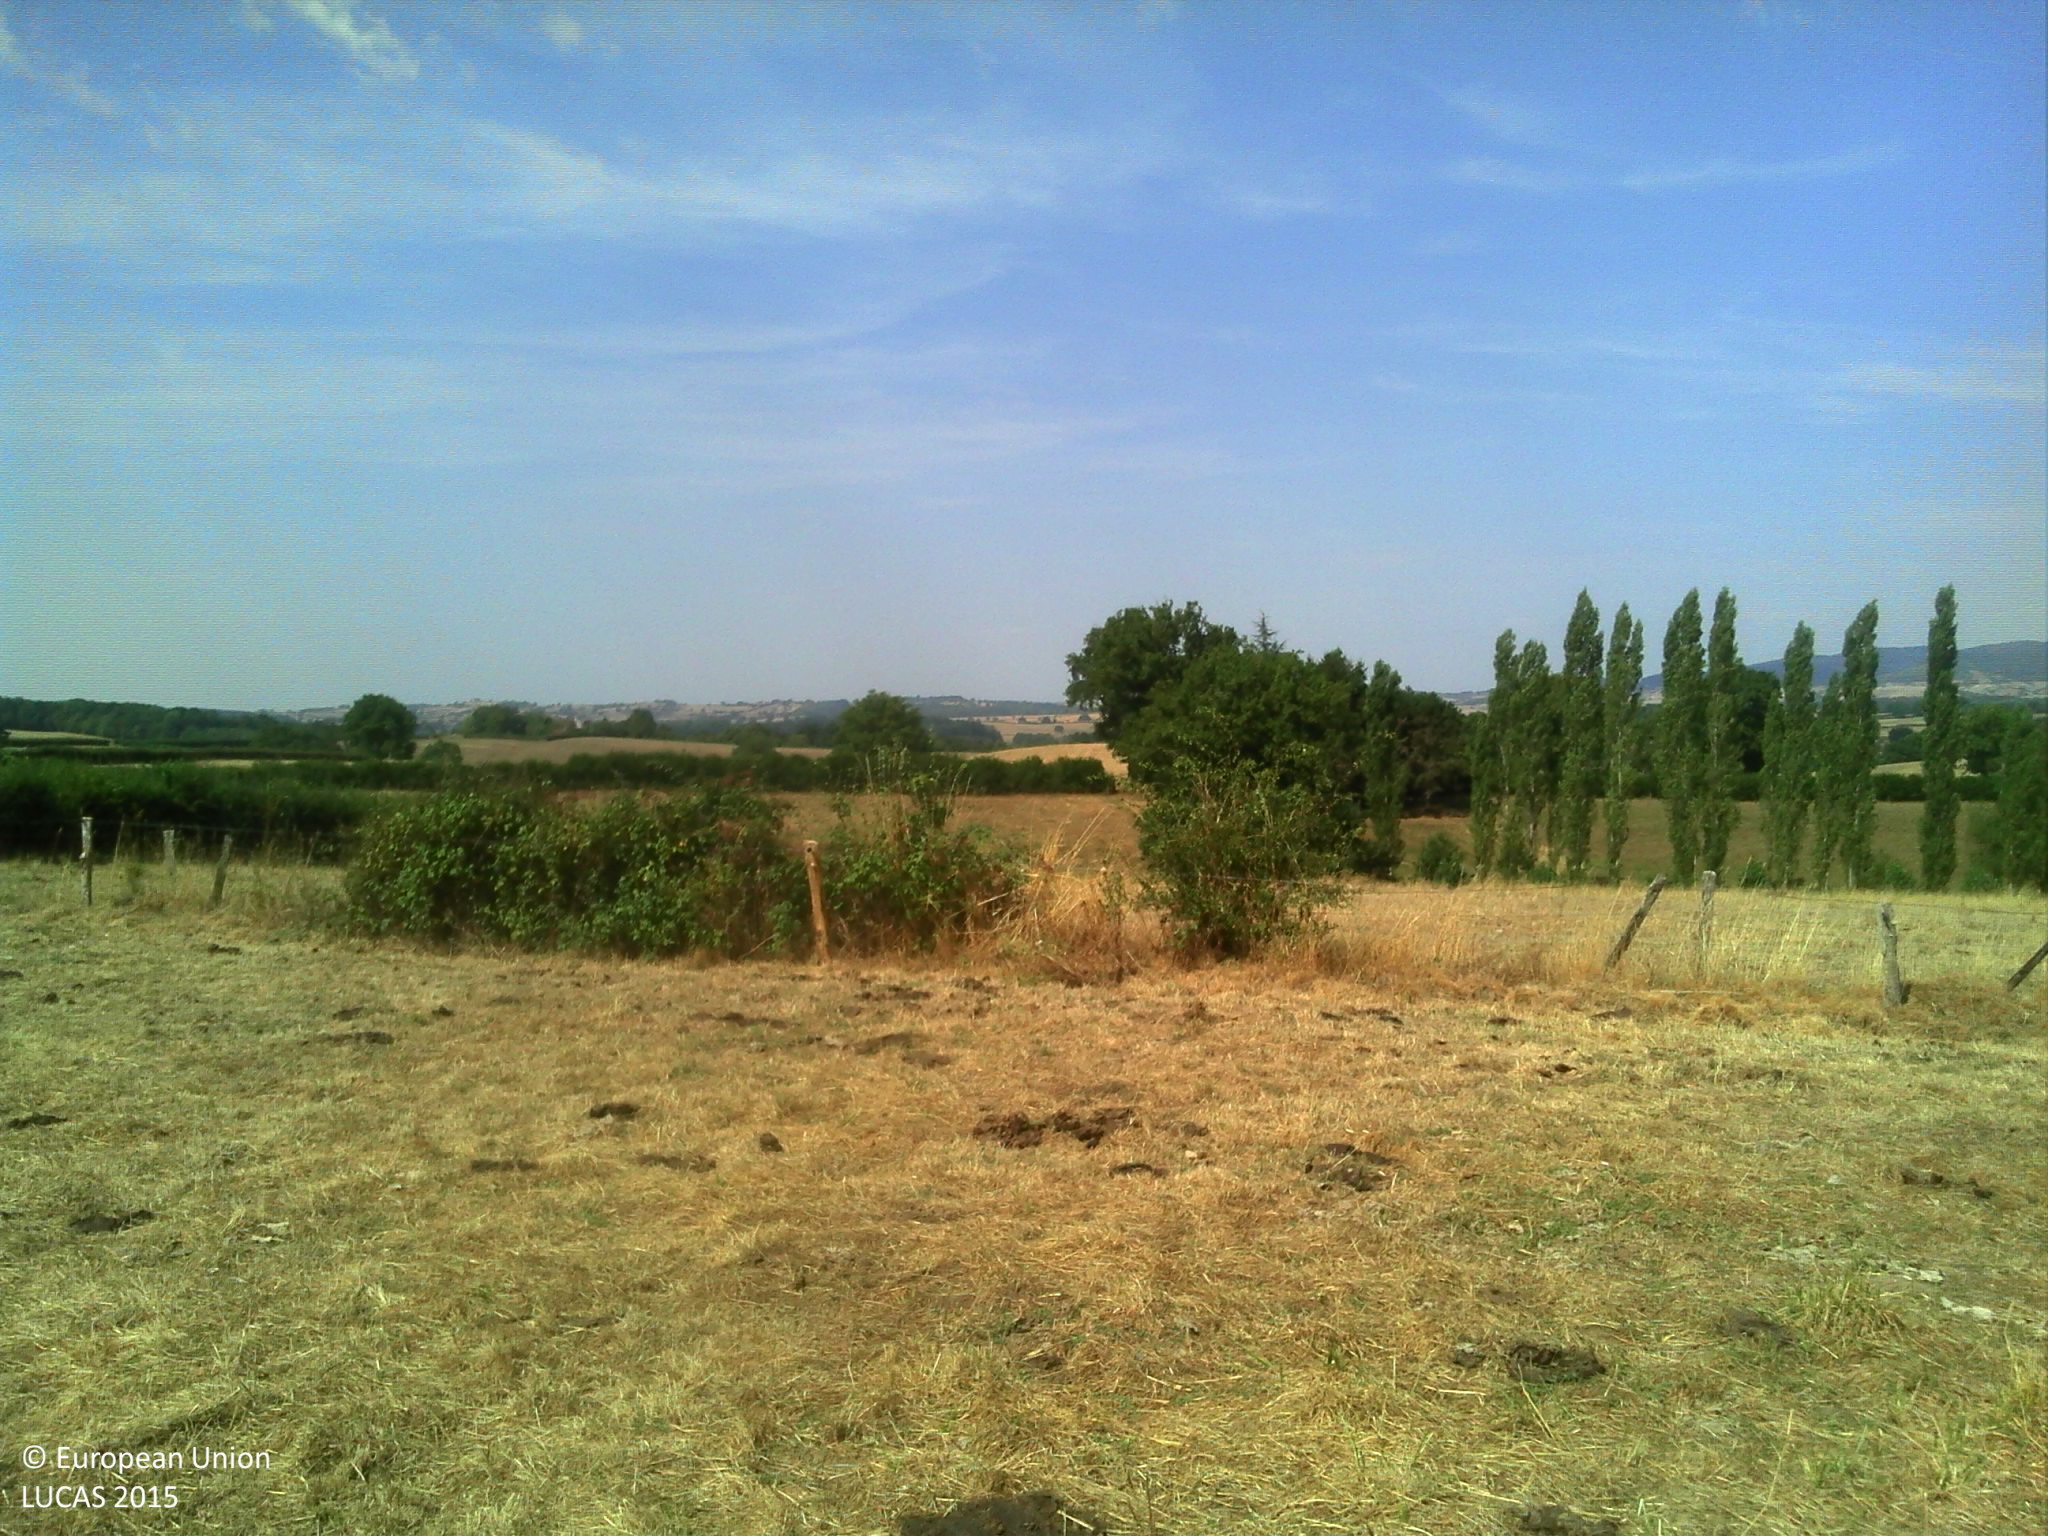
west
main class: Grassland
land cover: Grassland without tree/shrub cover
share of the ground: > 75 %
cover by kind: herbaceous plants 100 %
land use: Agriculture (excluding fallow land and kitchen gardens)
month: August
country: FR
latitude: 46.7453
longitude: 4.3853
